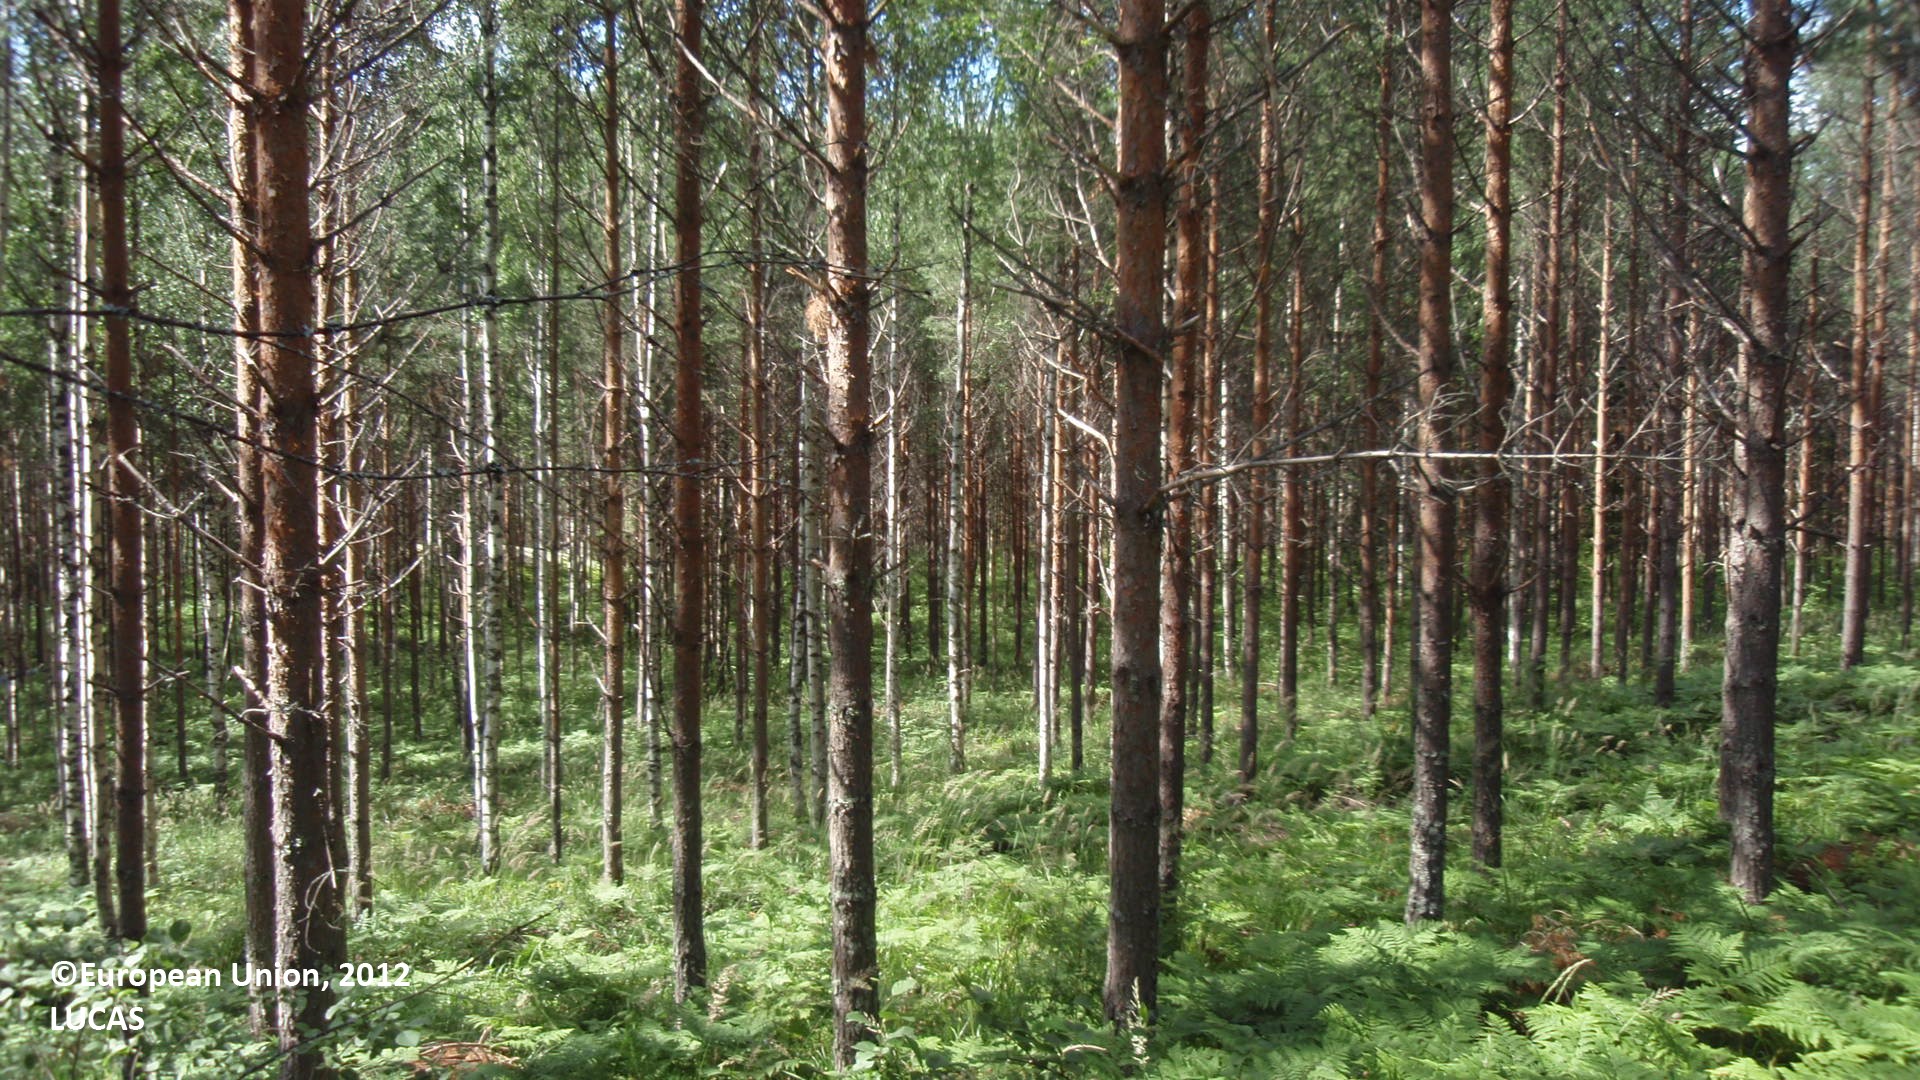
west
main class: Woodland
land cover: Pine dominated coniferous woodland
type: boreal forest
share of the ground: 50 - 75 %
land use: Forestry
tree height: > 5 m
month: July
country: FI
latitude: 61.5791
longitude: 28.4994
